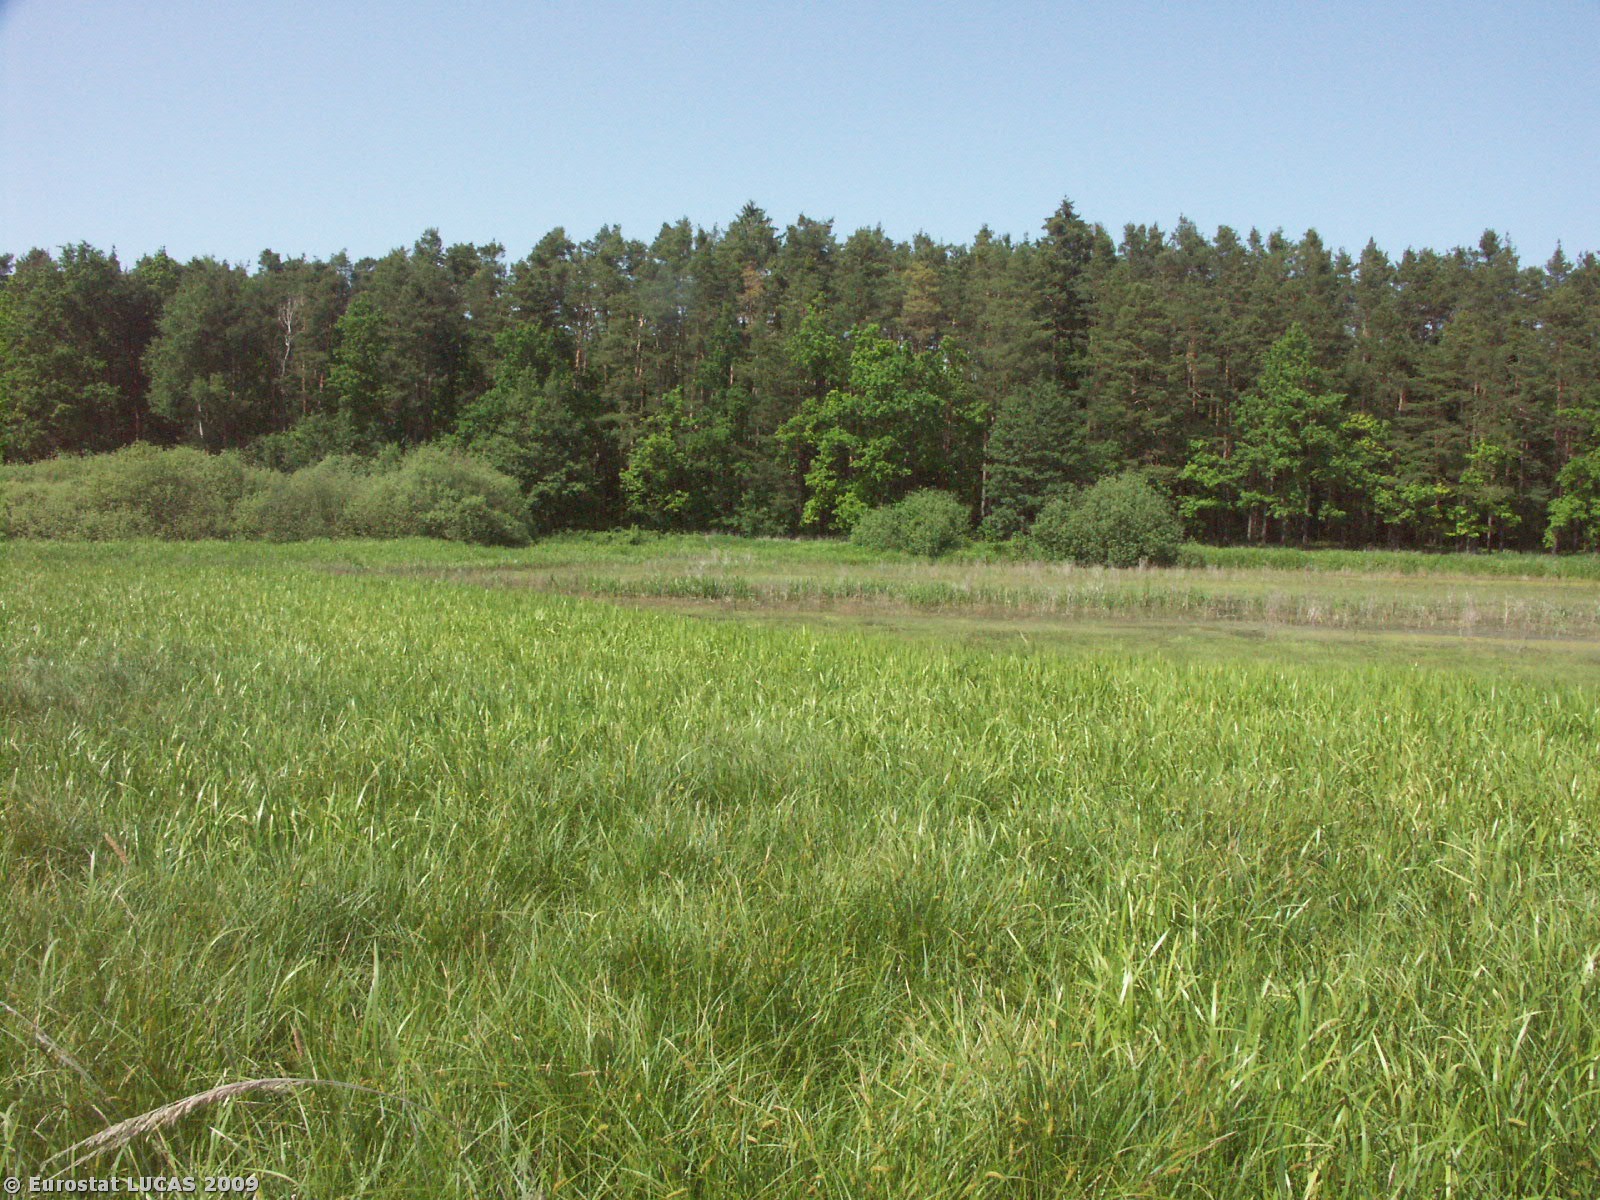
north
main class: Grassland
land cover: Grassland without tree/shrub cover
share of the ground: > 75 %
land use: Unused
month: May
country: CZ
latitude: 49.0450
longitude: 14.6394
